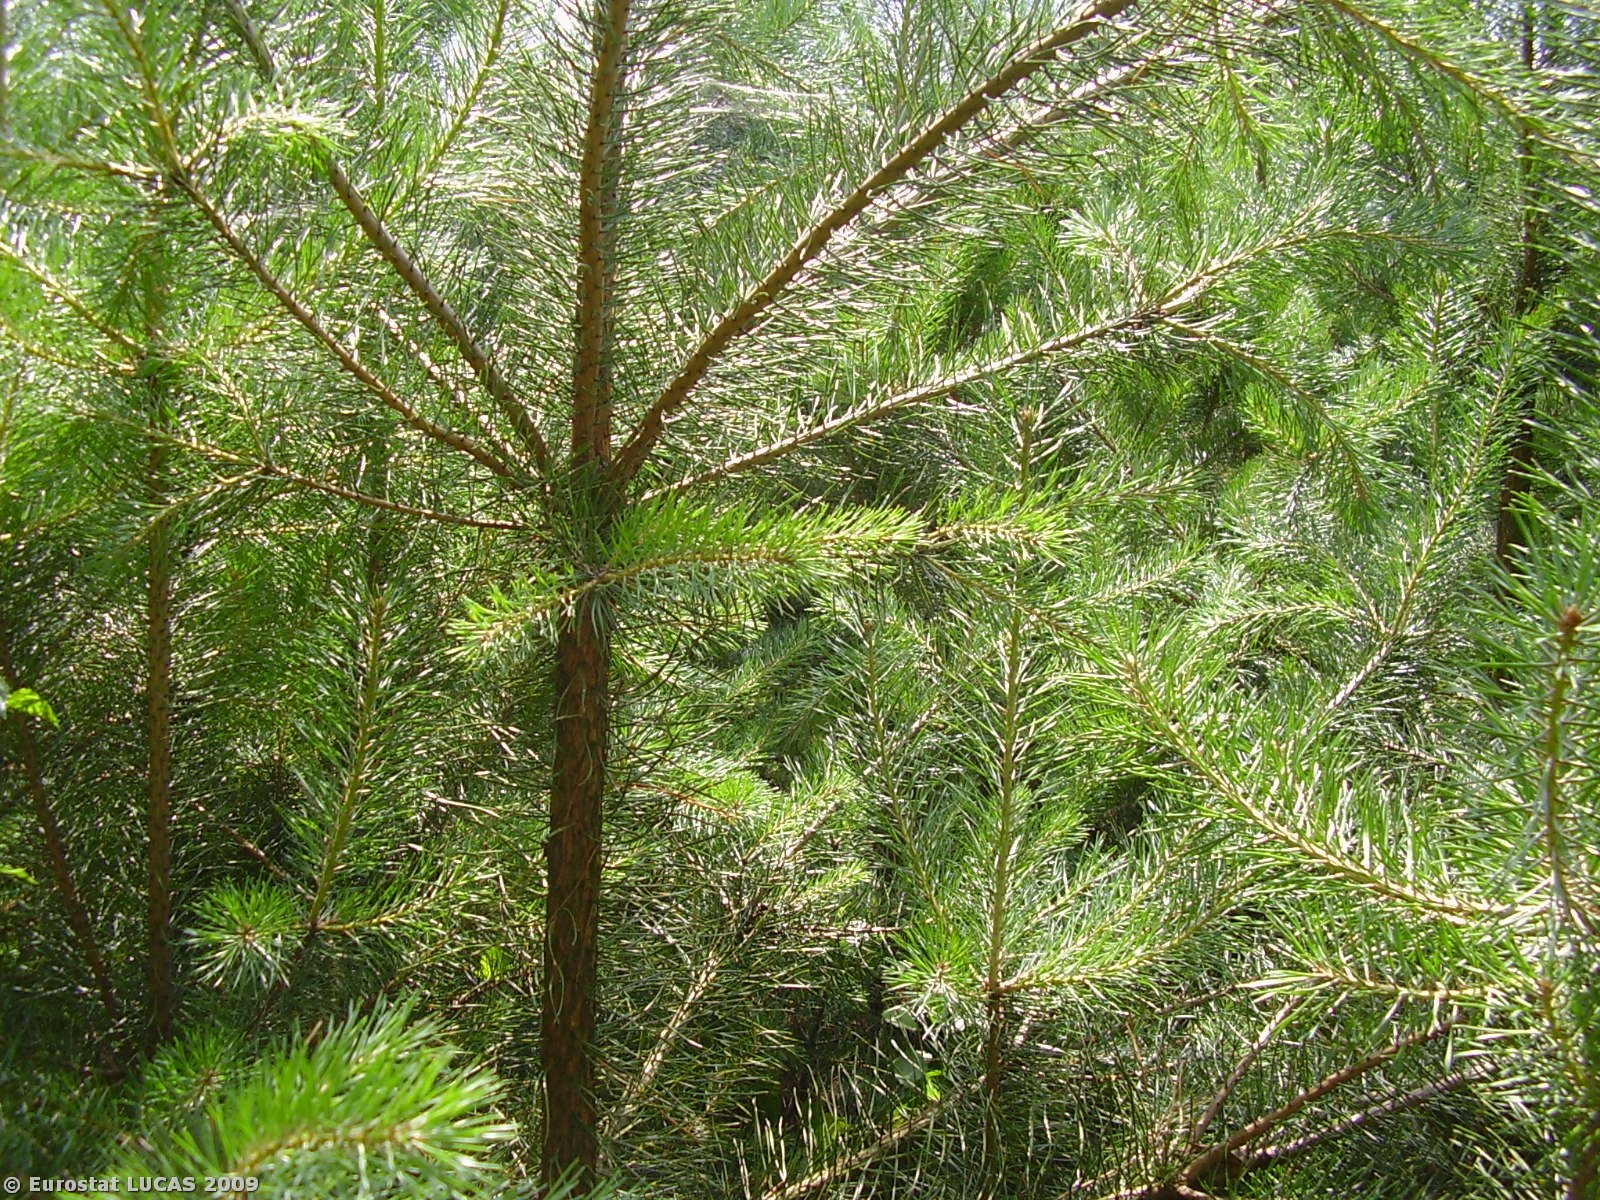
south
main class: Woodland
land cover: Mixed woodland
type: hemiboreal forest and nemoral coniferous forest and mixed broadleaved-coniferous forest
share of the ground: > 75 %
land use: Forestry
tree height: > 5 m
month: July
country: PL
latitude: 51.4209
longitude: 17.9971
